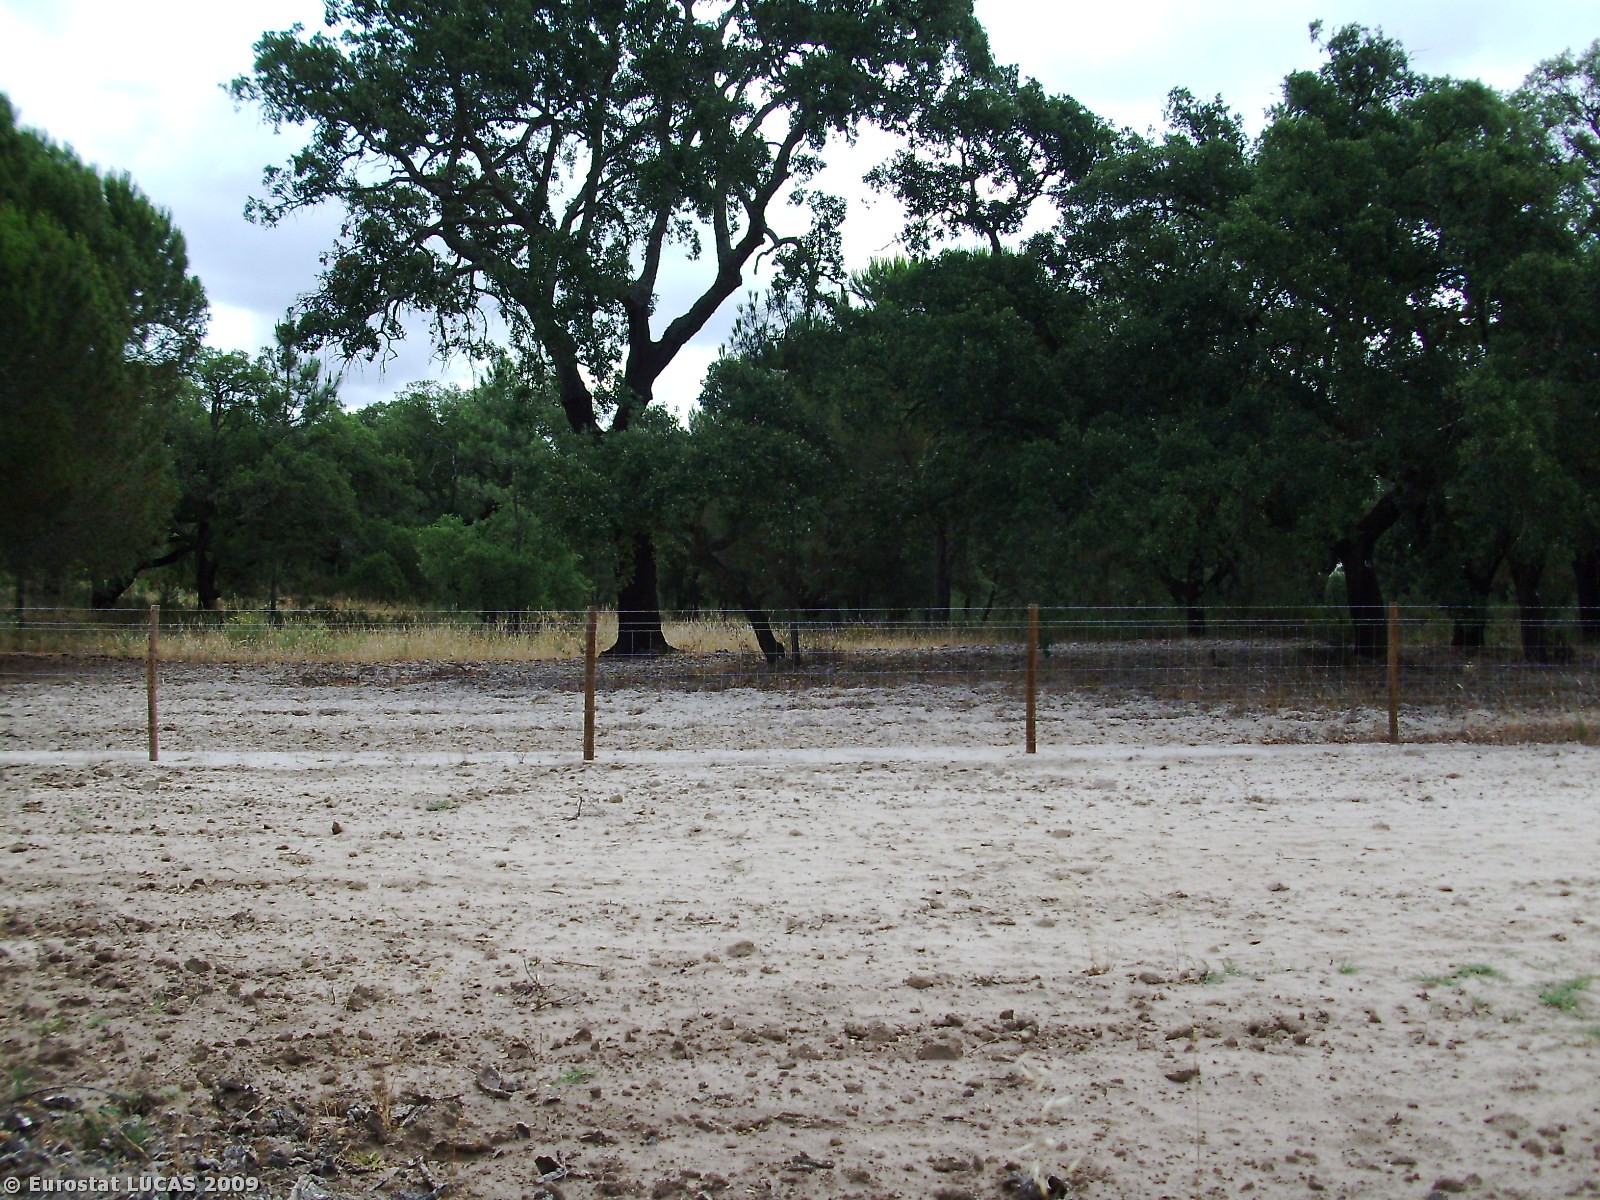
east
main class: Woodland
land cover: Broadleaved woodland
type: broadleaved evergreen forest
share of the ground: 10 - 25 %
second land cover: Bare land
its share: 10 - 25 %
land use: Forestry
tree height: > 5 m
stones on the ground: < 10 %
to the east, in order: Broadleaved woodland; Bare land; Broadleaved woodland; Bare land; Fences; Broadleaved woodland
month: June
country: PT
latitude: 38.2976
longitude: -8.5395
